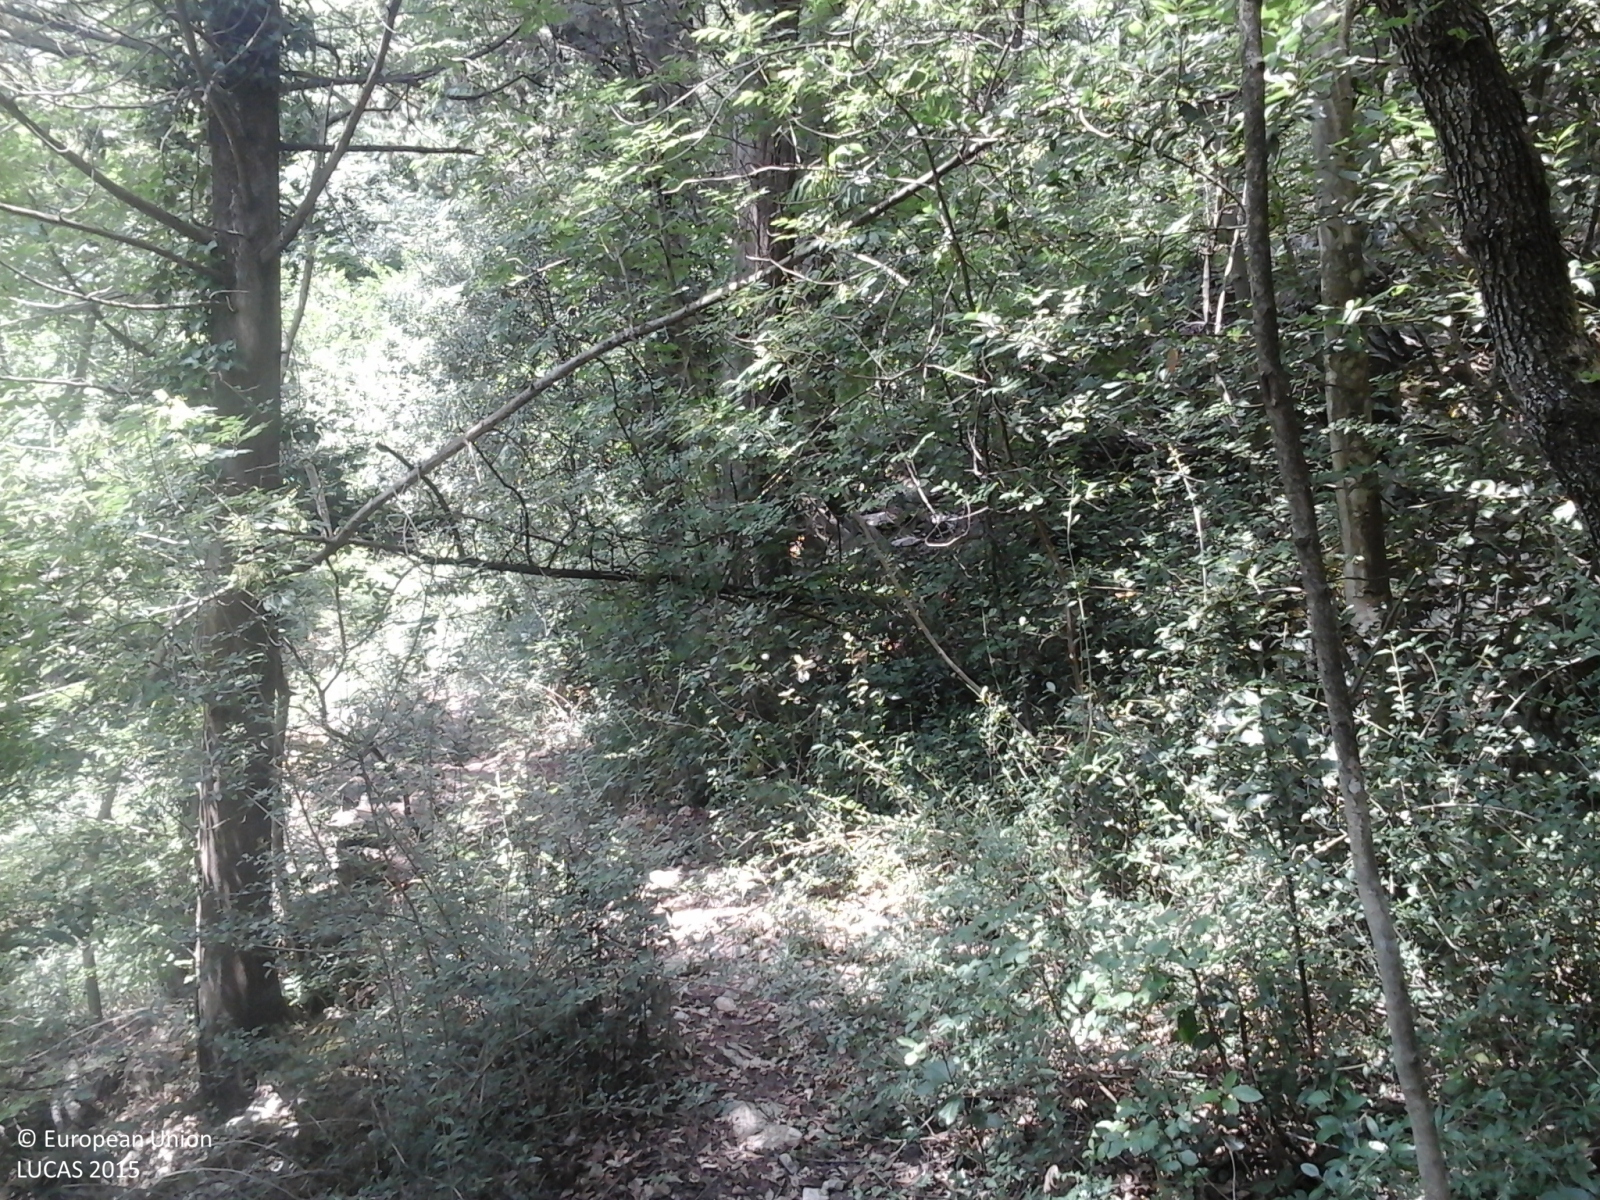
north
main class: Woodland
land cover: Other mixed woodland
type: thermophilous deciduous forest
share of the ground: > 75 %
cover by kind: broadleaved forest trees 75 %, coniferous forest trees 25 %
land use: Forestry
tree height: > 5 m
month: June
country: IT
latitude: 43.9303
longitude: 11.0561
